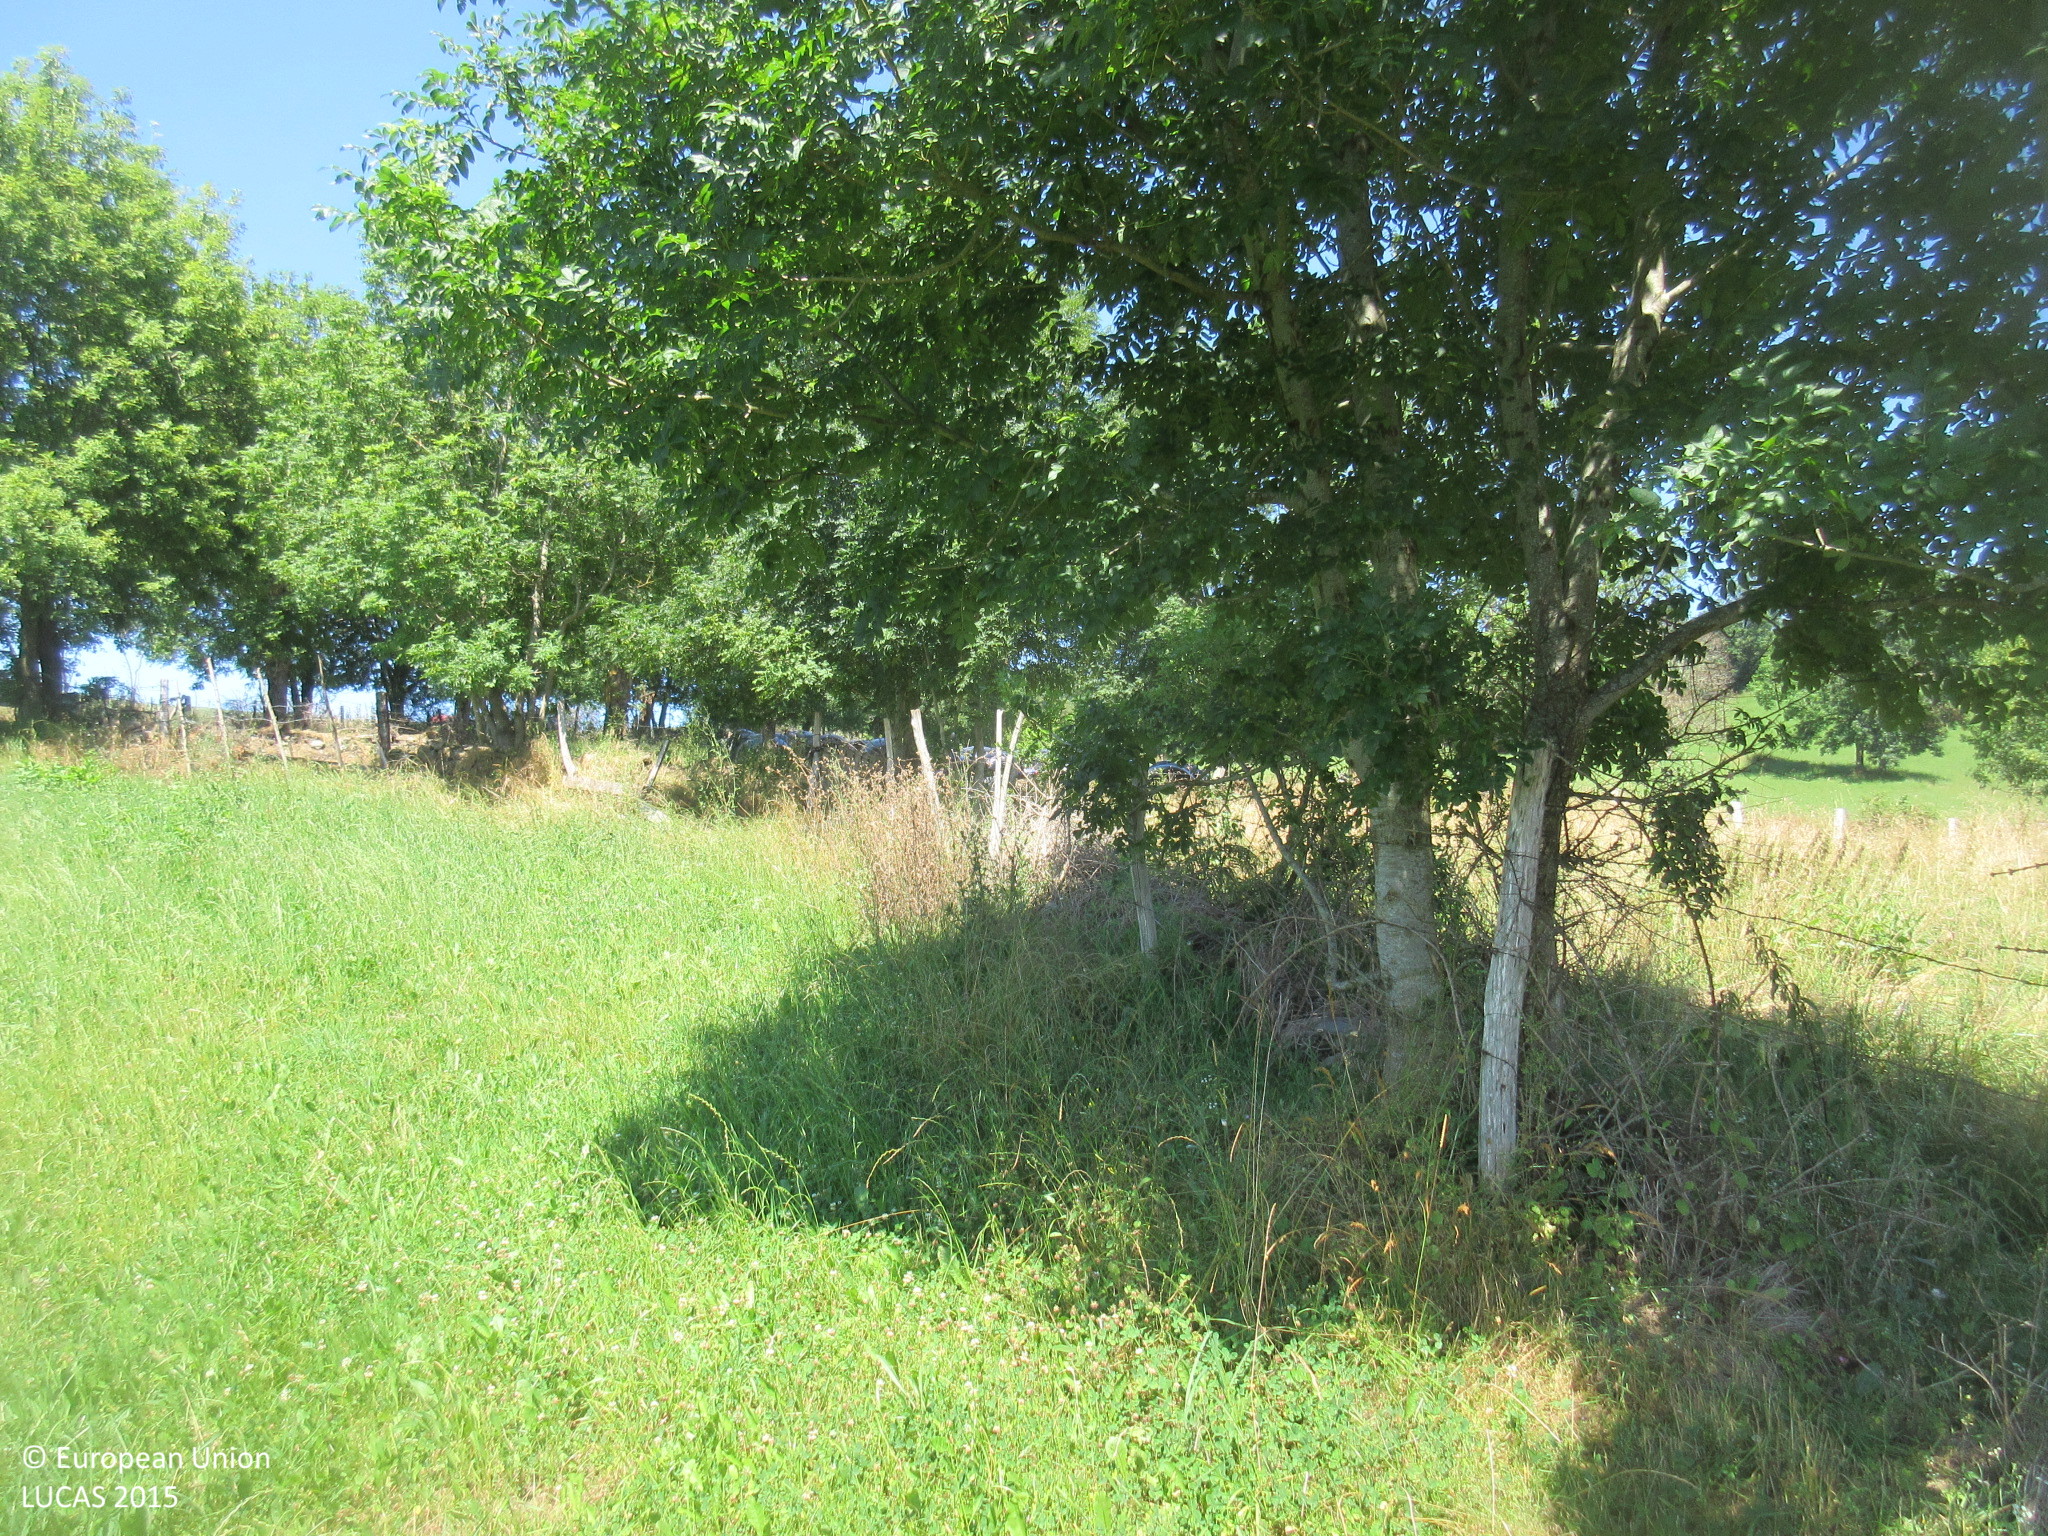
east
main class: Grassland
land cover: Grassland without tree/shrub cover
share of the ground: > 75 %
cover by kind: herbaceous plants 100 %
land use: Agriculture (excluding fallow land and kitchen gardens)
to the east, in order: Grassland without tree/shrub cover; Fences; Shruby margins; Grassland without tree/shrub cover; Fences; Grass margins; Paved roads, cycling and walking lanes; Dry stone walls; Groves; Fences; Grassland without tree/shrub cover; Groves; Fences; Grassland without tree/shrub cover
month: July
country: ES
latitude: 43.2183
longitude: -3.4222
